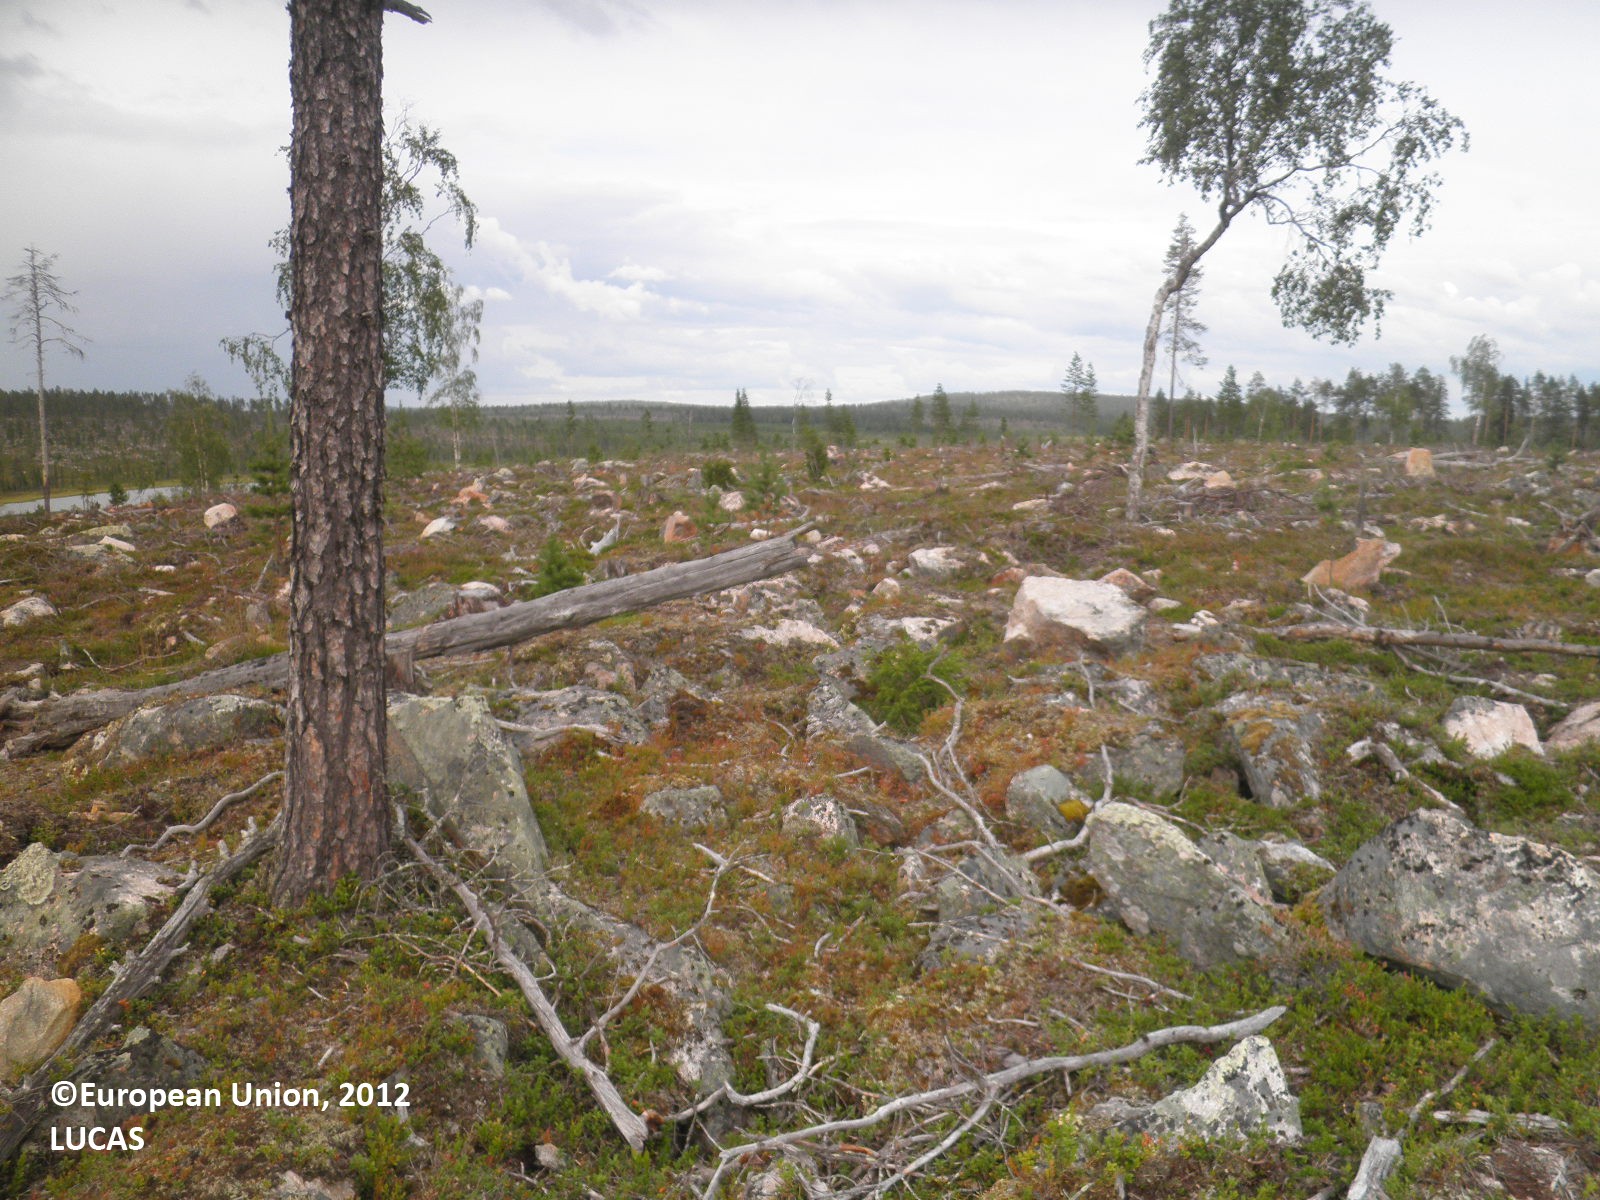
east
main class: Grassland
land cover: Grassland with sparse tree/shrub cover
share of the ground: > 75 %
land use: Forestry
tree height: < 5 m
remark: Clear cut
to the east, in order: Grassland with sparse tree/shrub cover
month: August
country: FI
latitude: 67.2735
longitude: 29.2486
